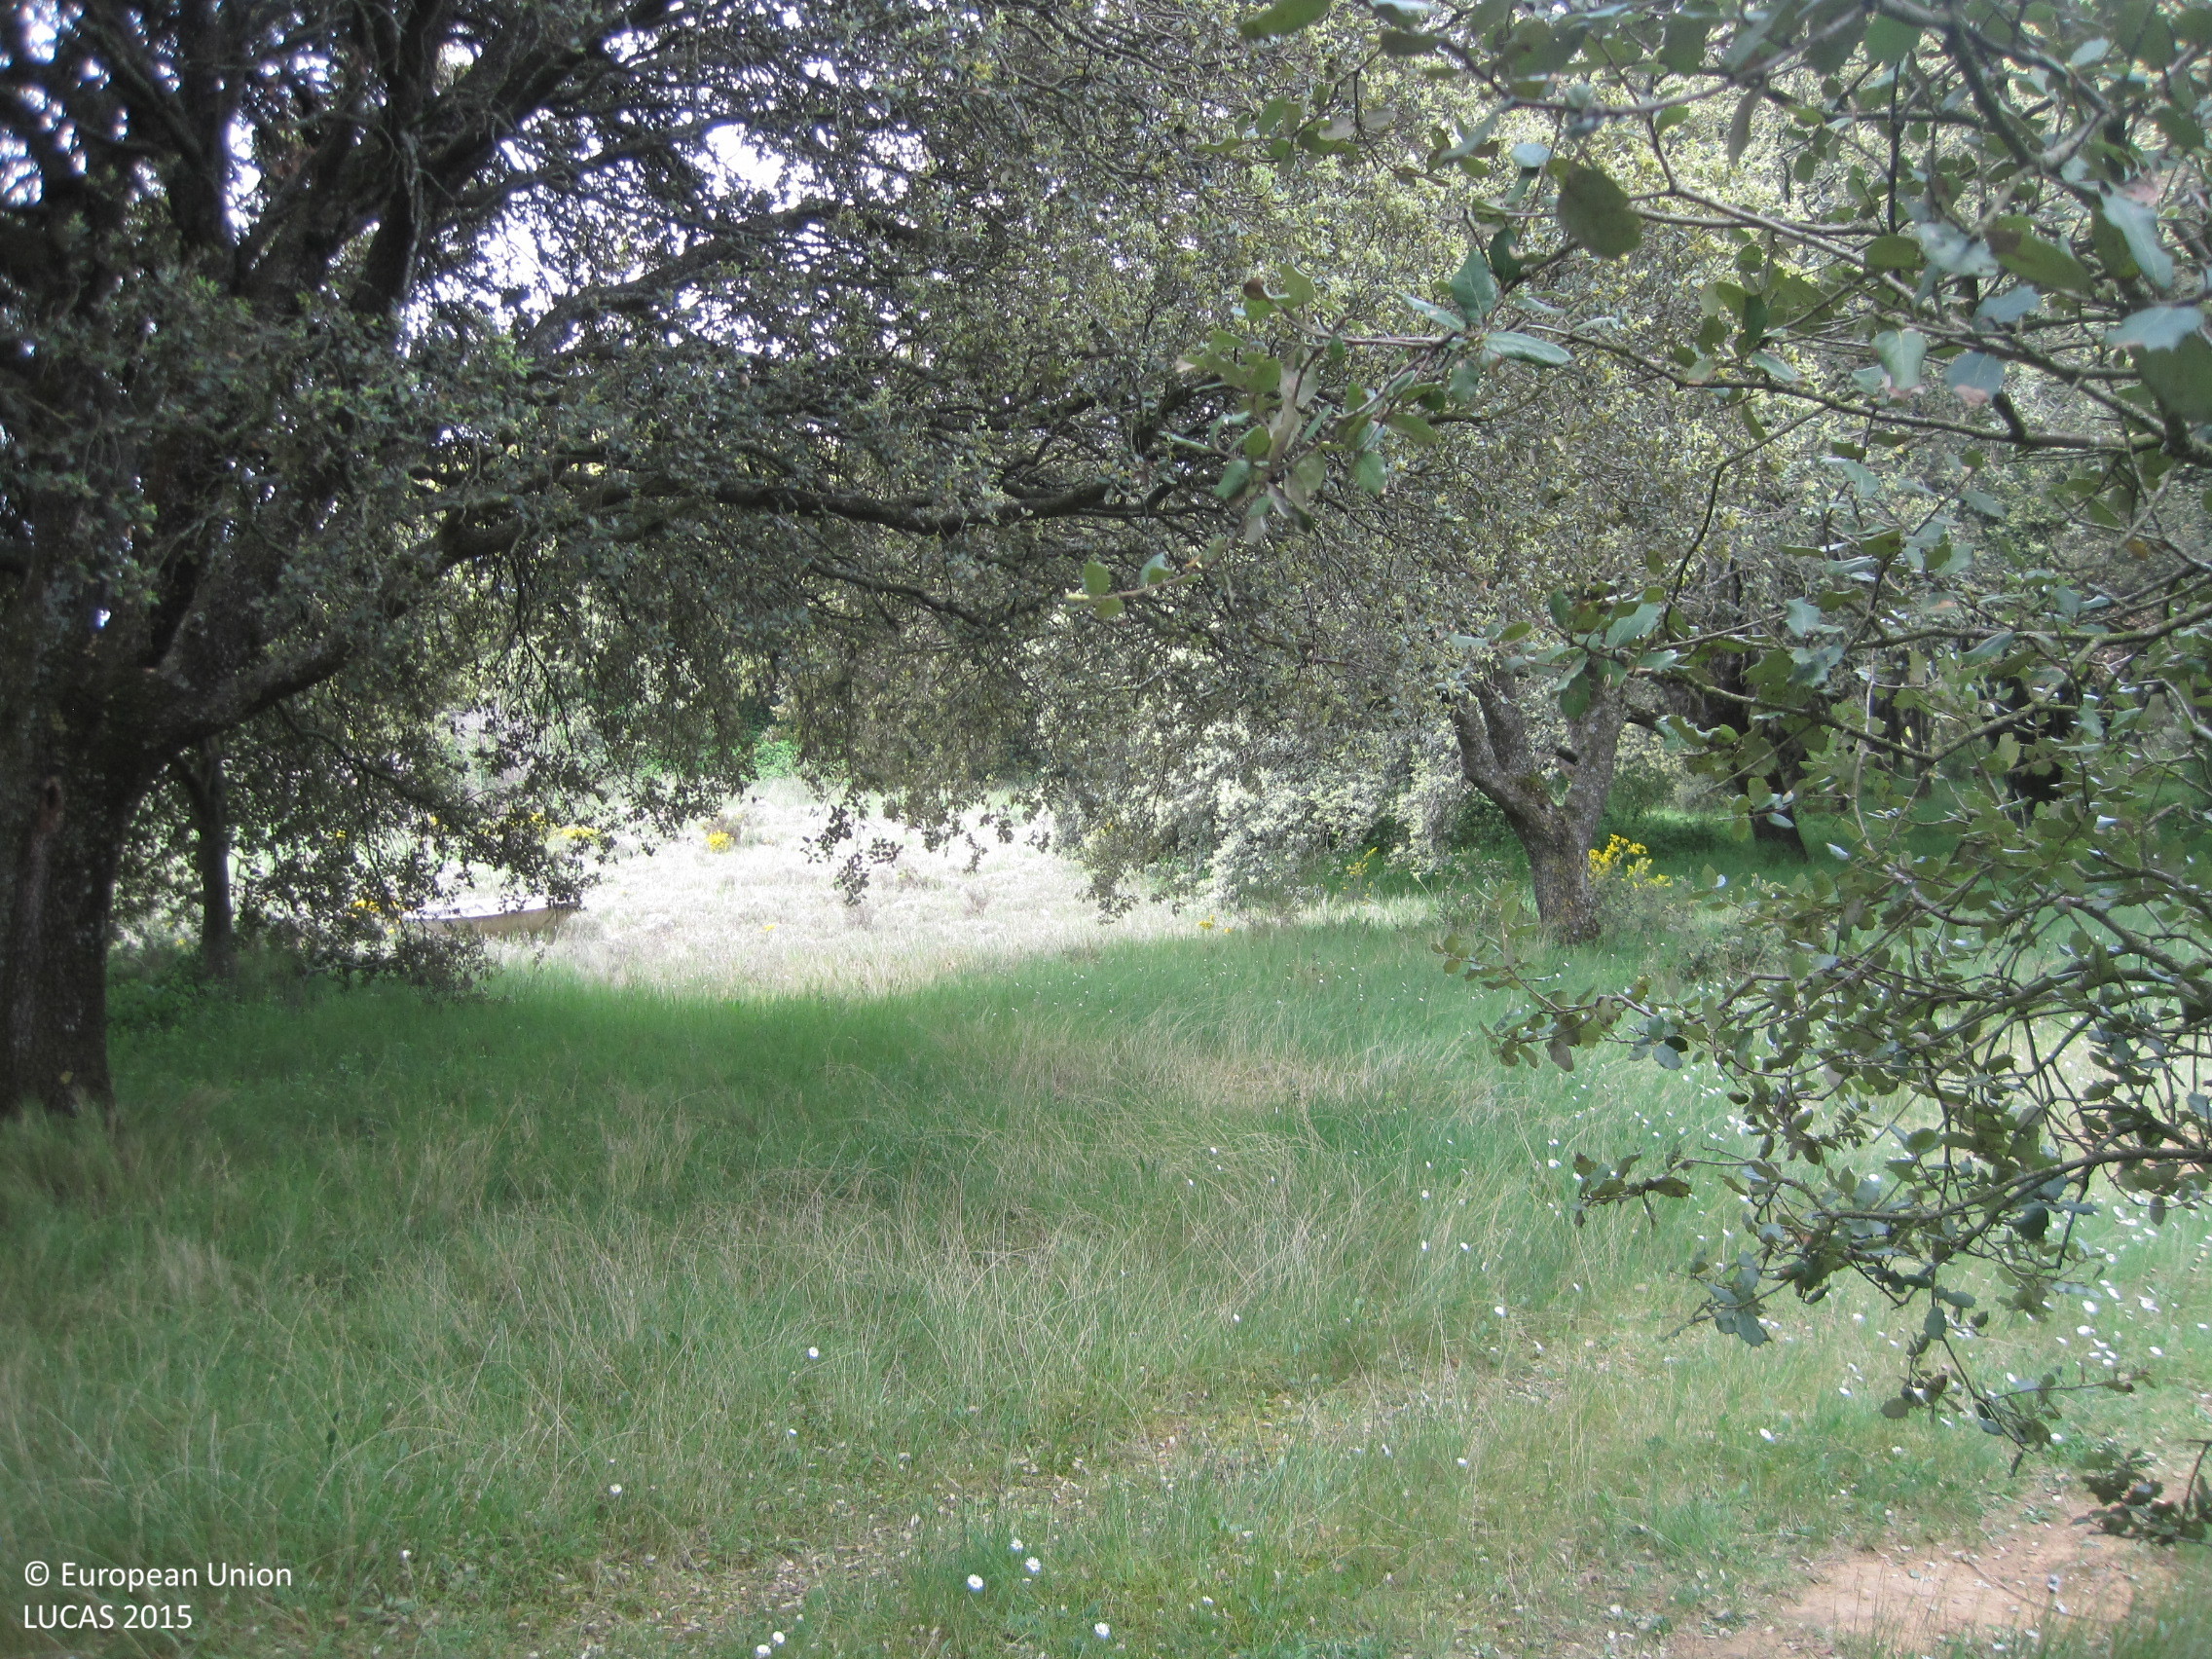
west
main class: Woodland
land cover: Broadleaved woodland
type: acidophilous oak and oak-birch forest
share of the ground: 50 - 75 %
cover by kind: broadleaved forest trees 50 %, herbaceous plants 35 %, shrubs 10 %, unconsolidated bare surface 5 %
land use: Semi-natural and natural areas not in use
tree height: > 5 m
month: May
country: ES
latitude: 42.7151
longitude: -1.7491
